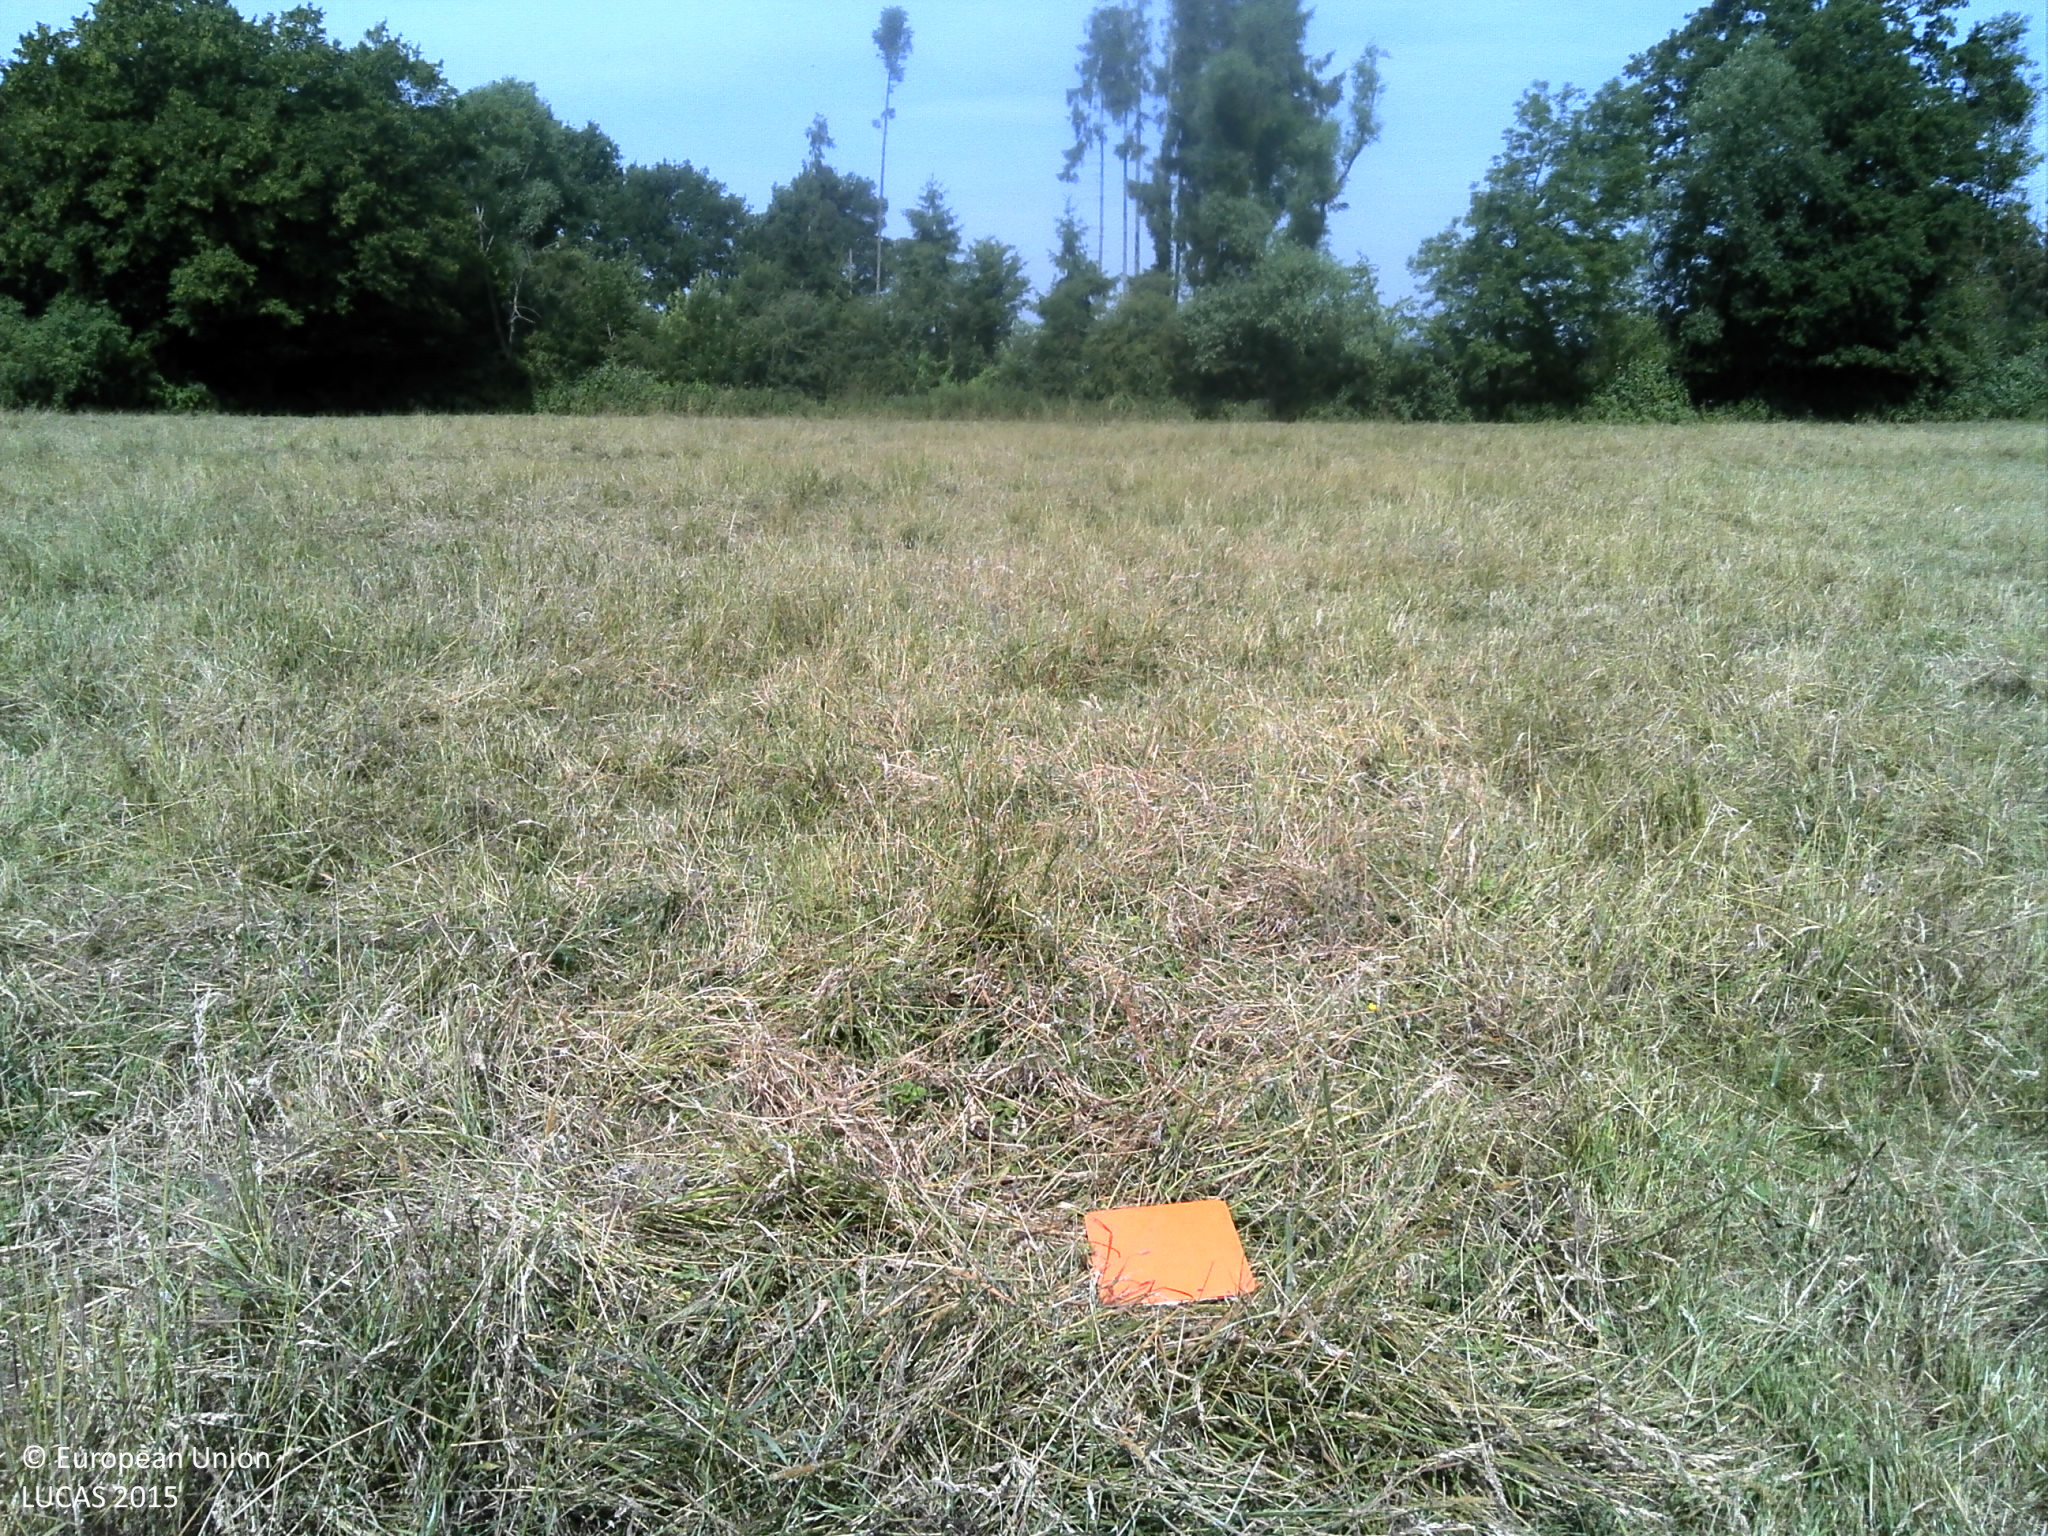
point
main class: Grassland
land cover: Grassland without tree/shrub cover
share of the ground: > 75 %
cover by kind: herbaceous plants 100 %
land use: Agriculture (excluding fallow land and kitchen gardens)
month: June
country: FR
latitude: 49.3473
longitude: 6.2142
